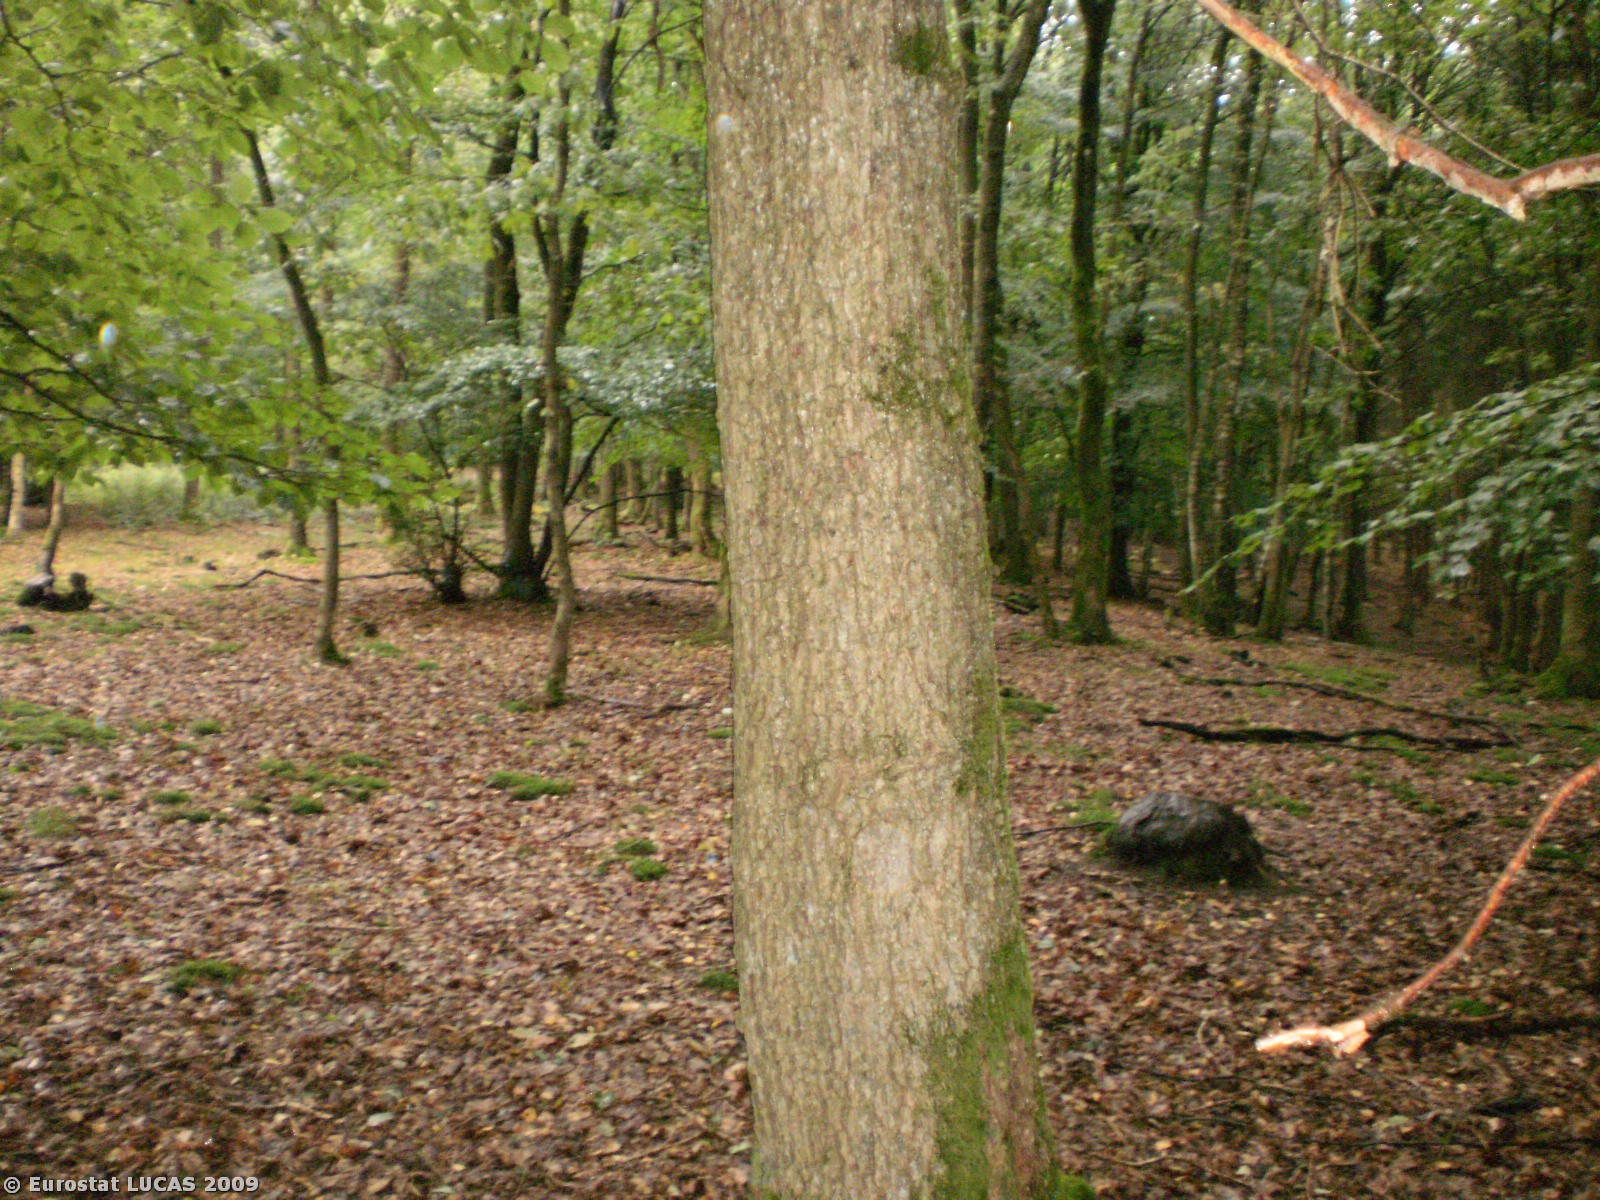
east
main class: Woodland
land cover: Broadleaved woodland
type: beech forest
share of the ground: > 75 %
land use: Nature reserves
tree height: > 5 m
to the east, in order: Broadleaved woodland; Tracks; Fences; Grassland without tree/shrub cover
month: September
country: BE
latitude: 50.3335
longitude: 5.6011
